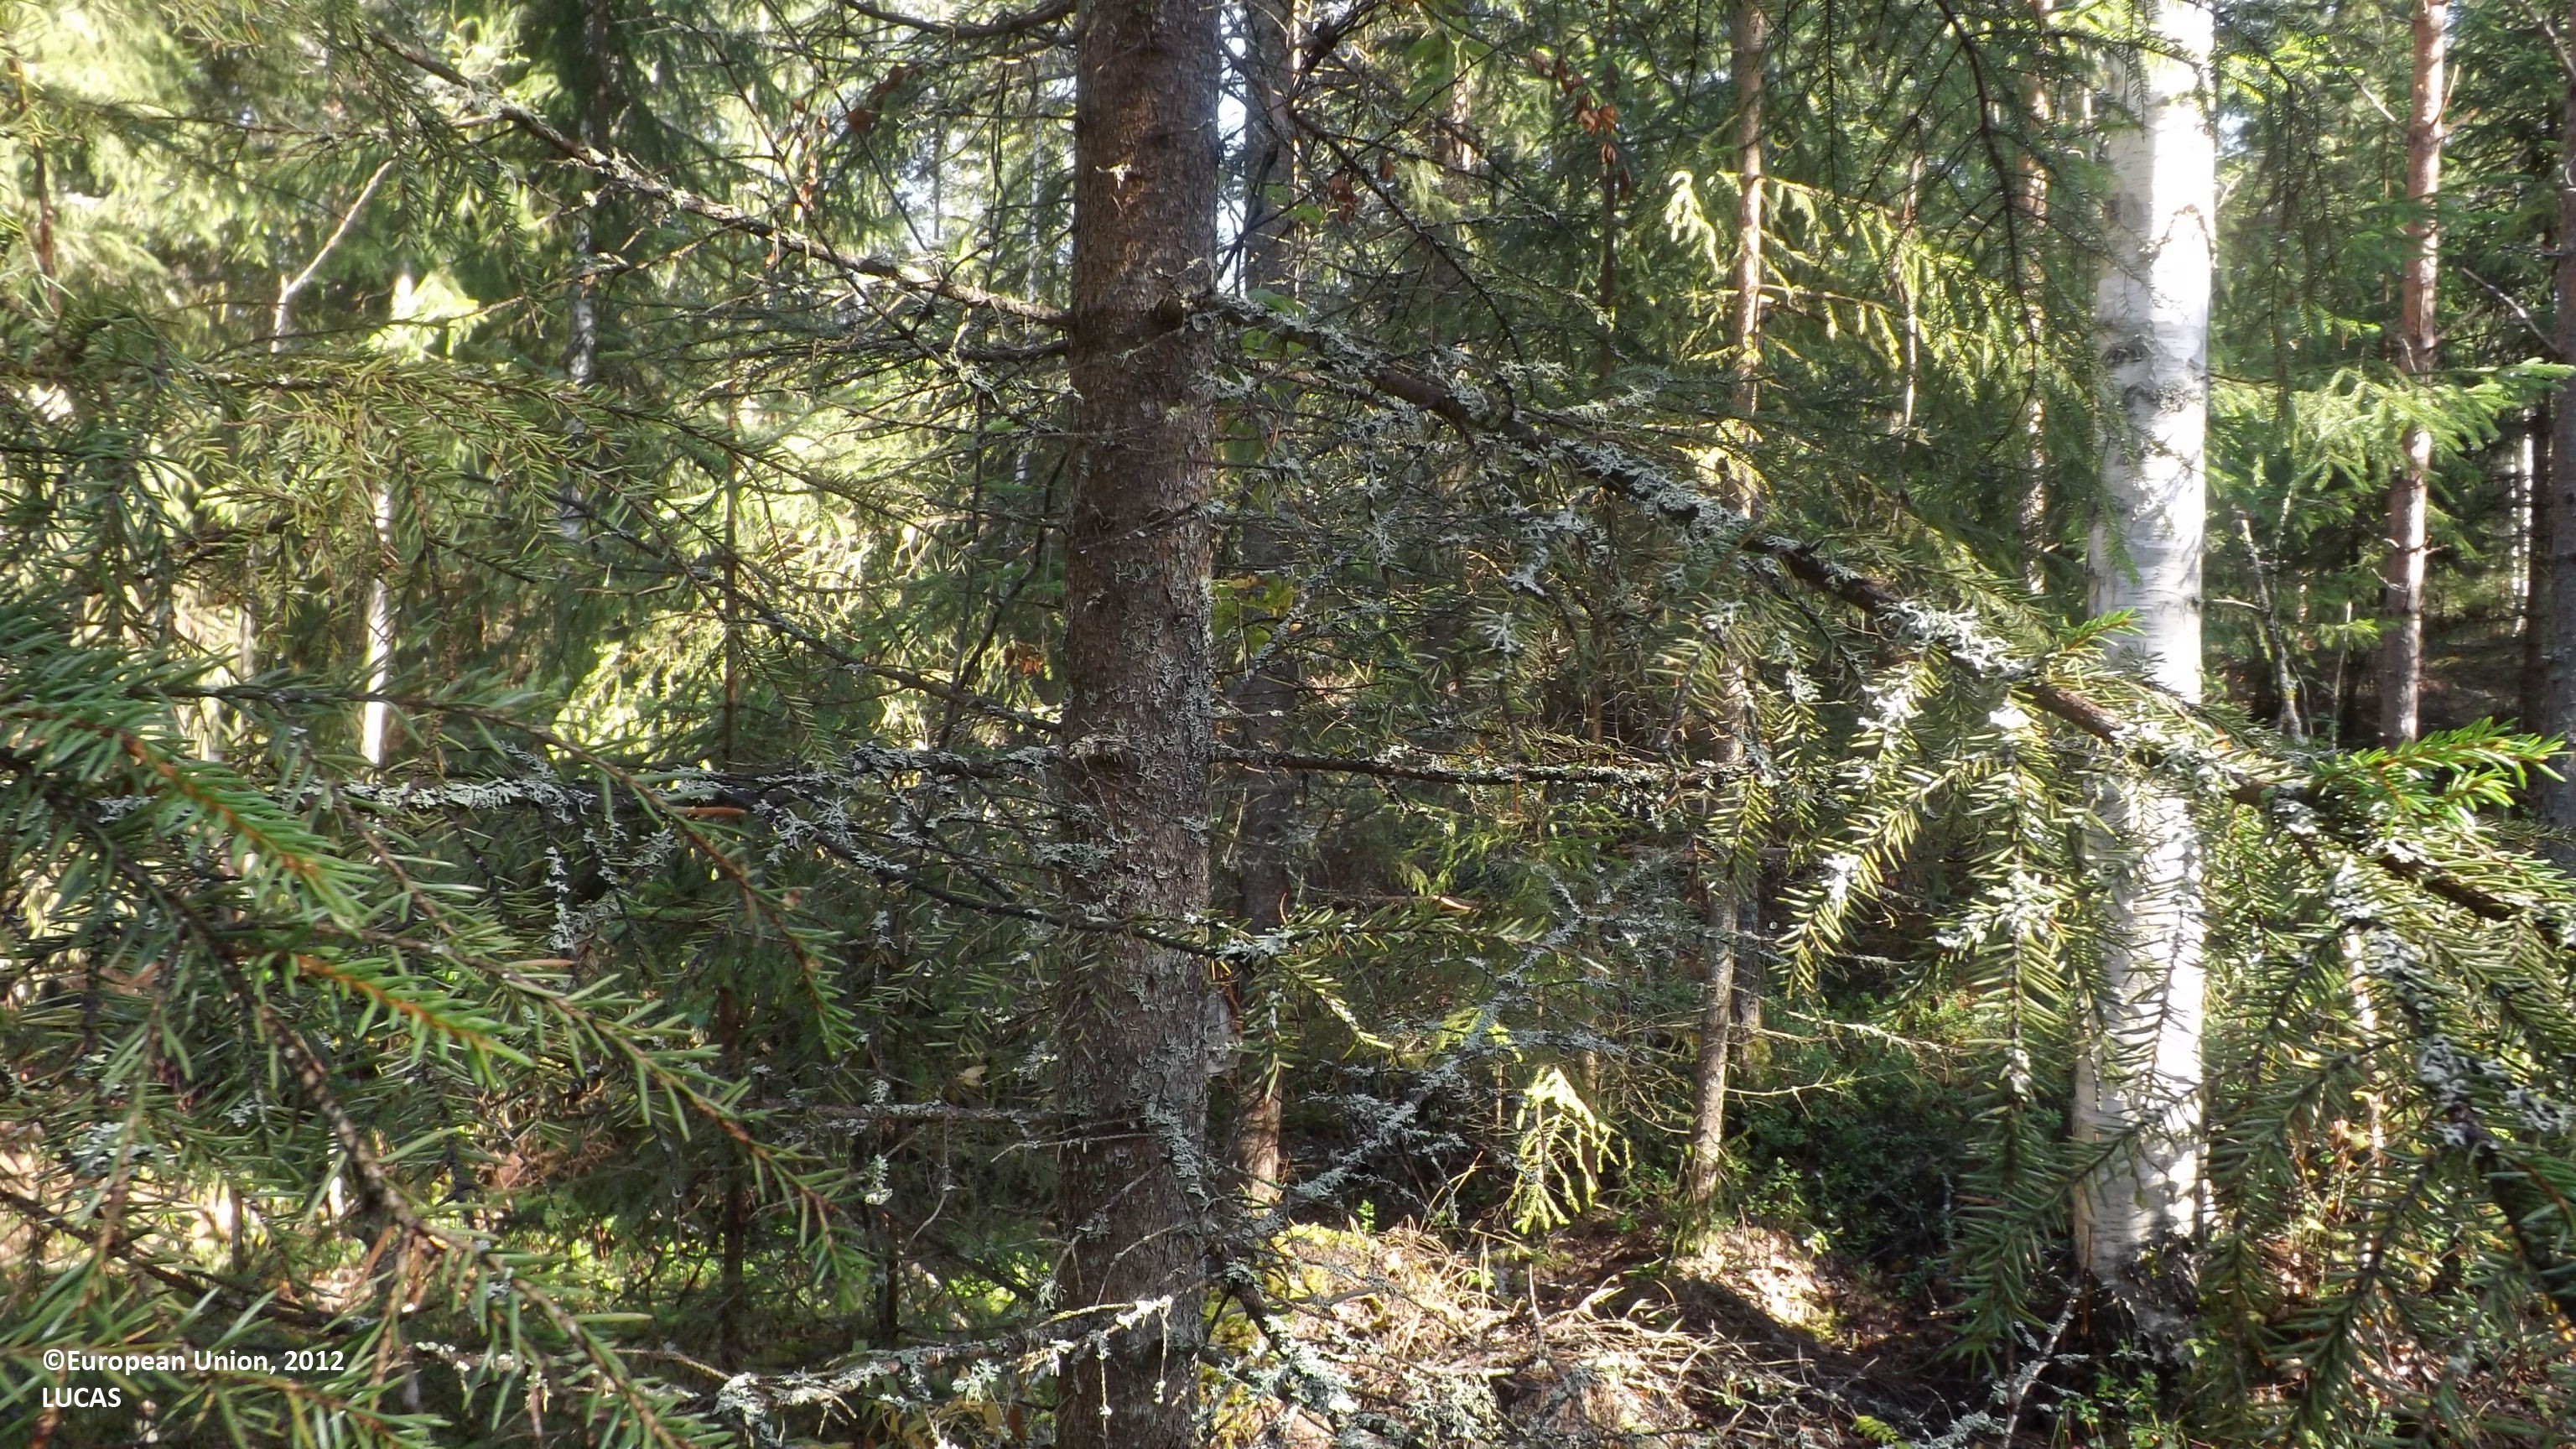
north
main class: Woodland
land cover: Spruce dominated mixed woodland
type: boreal forest
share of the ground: 50 - 75 %
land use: Forestry
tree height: > 5 m
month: August
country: FI
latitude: 63.6467
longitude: 23.7751
